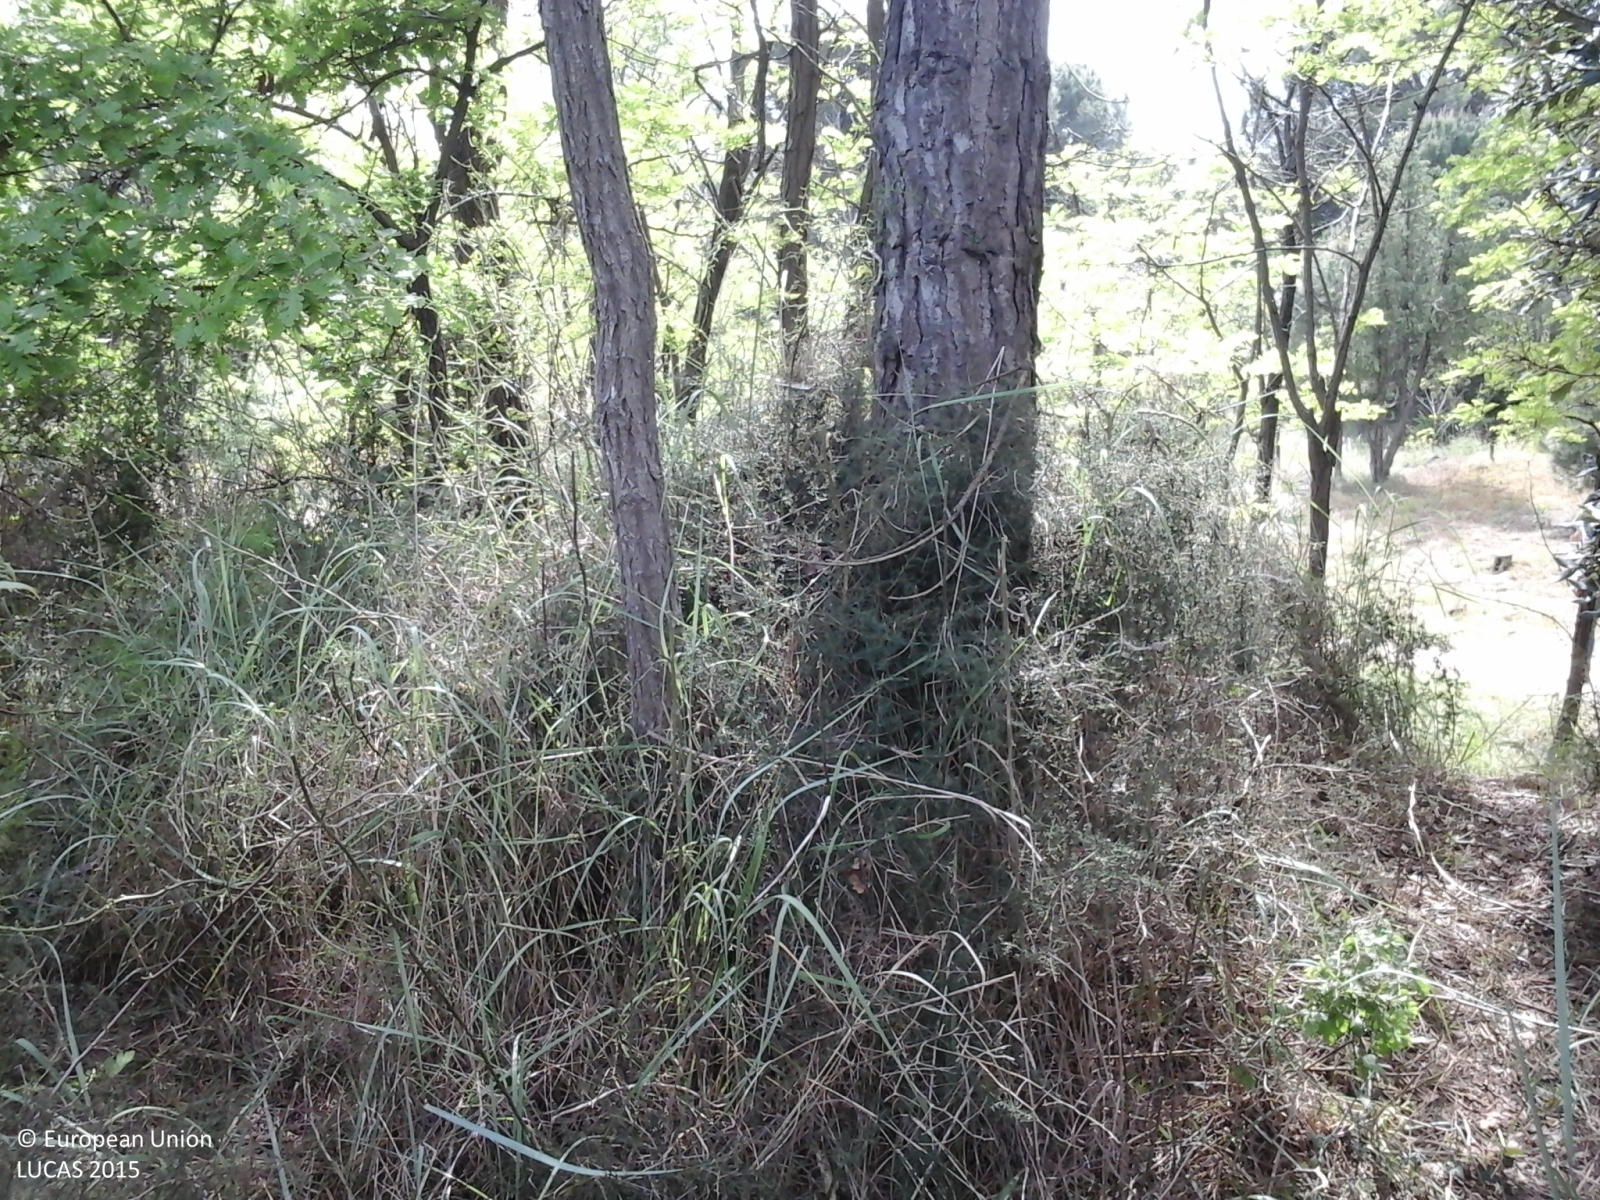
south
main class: Woodland
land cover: Pine dominated mixed woodland
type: coniferous forest of the mediterranean region
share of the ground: > 75 %
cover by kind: coniferous forest trees 40 %, broadleaved forest trees 20 %, shrubs 20 %, herbaceous plants 20 %
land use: Amenities, museums, leisure
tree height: > 5 m
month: May
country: IT
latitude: 45.5241
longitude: 12.6975
